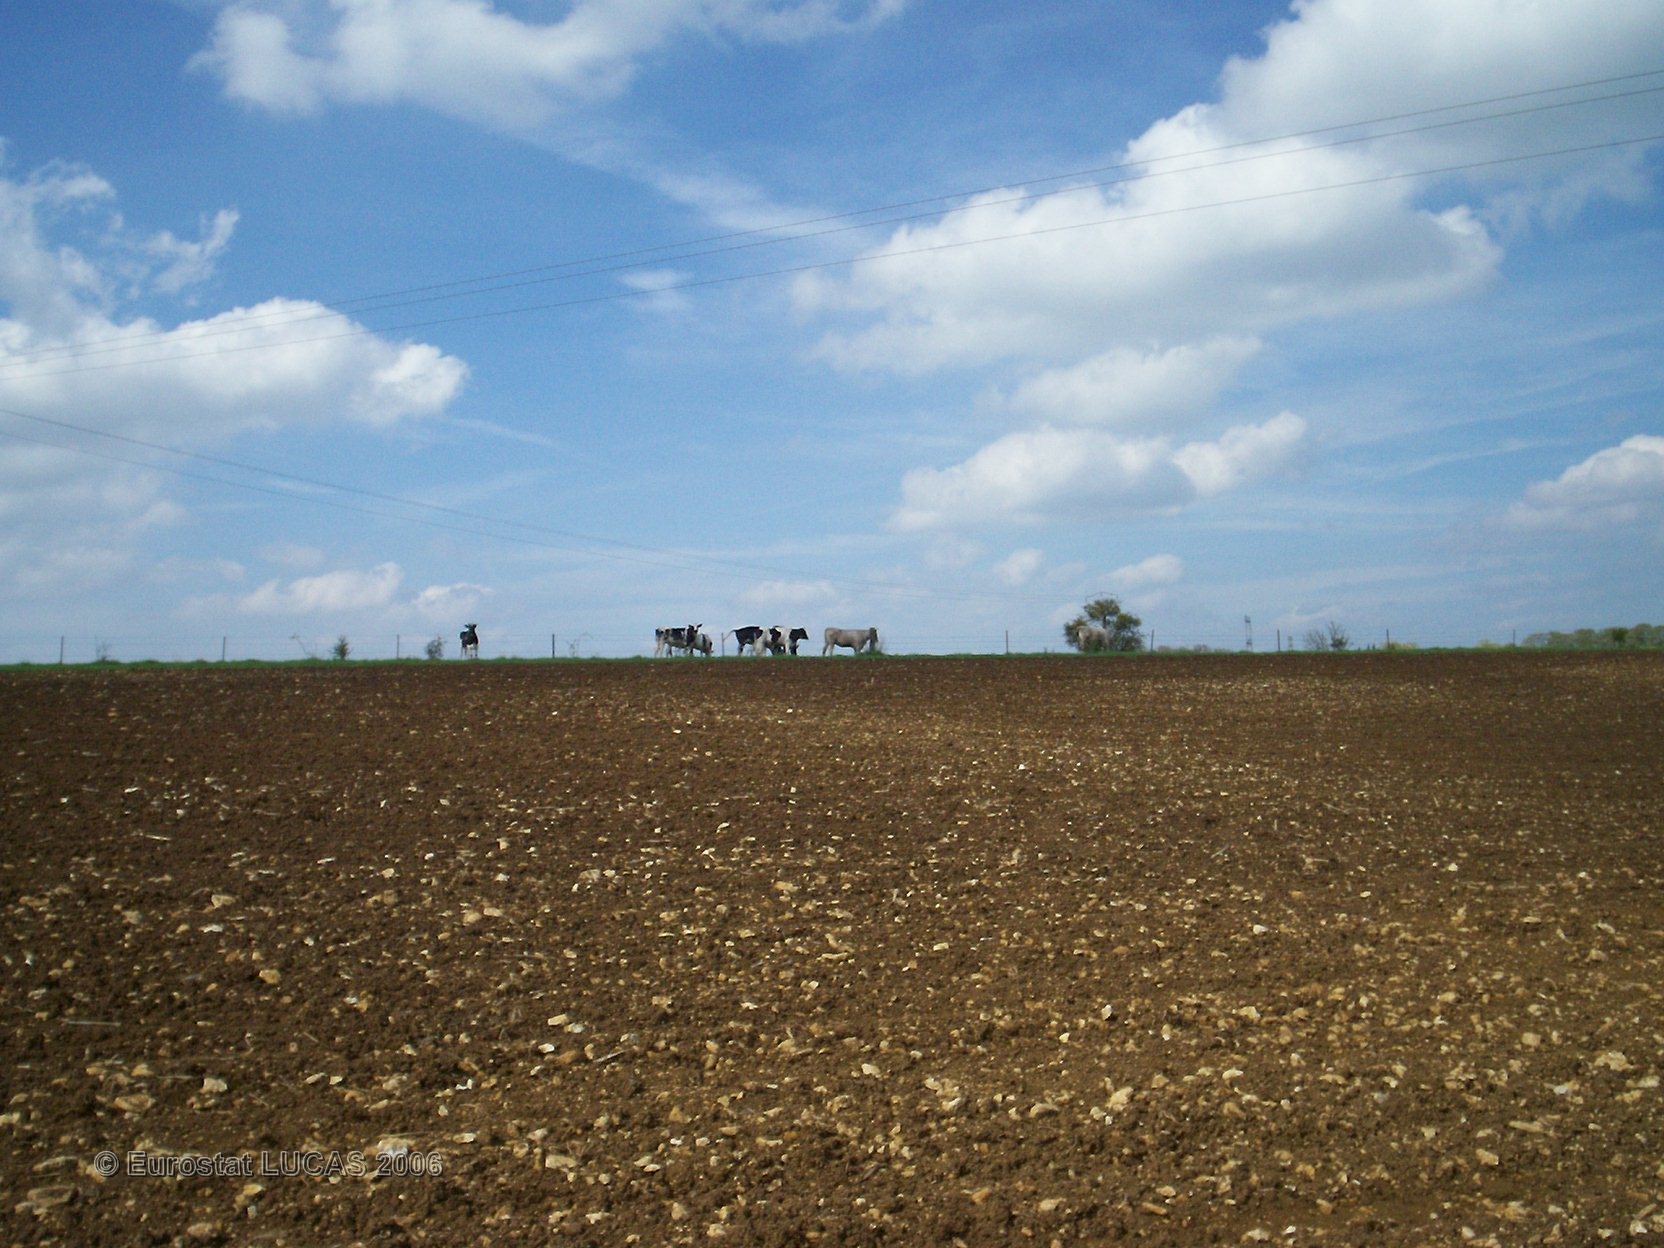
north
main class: Cropland
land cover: Maize
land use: Agriculture (excluding fallow land and kitchen gardens)
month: May
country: FR
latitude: 49.8245
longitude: 4.2824
